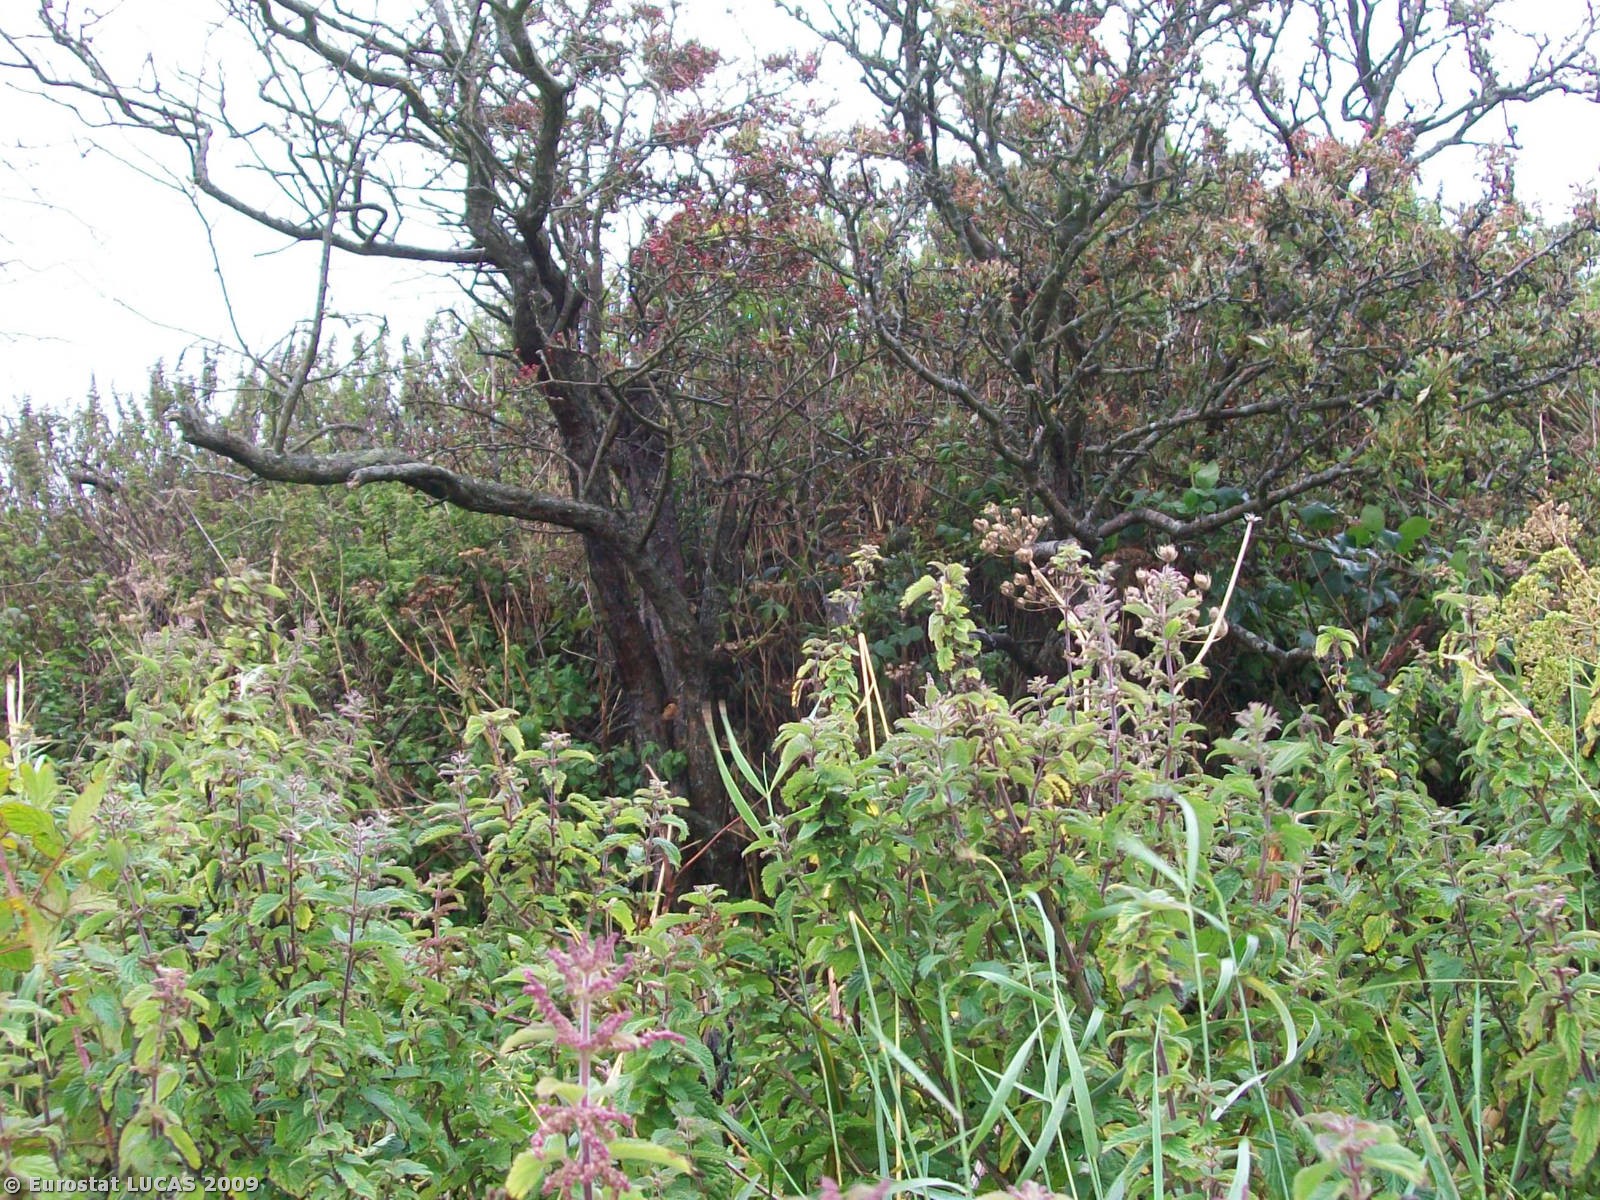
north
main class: Grassland
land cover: Spontaneously vegetated surfaces
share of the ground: > 75 %
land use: Fallow land
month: August
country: GB
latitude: 54.3142
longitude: -5.5468
